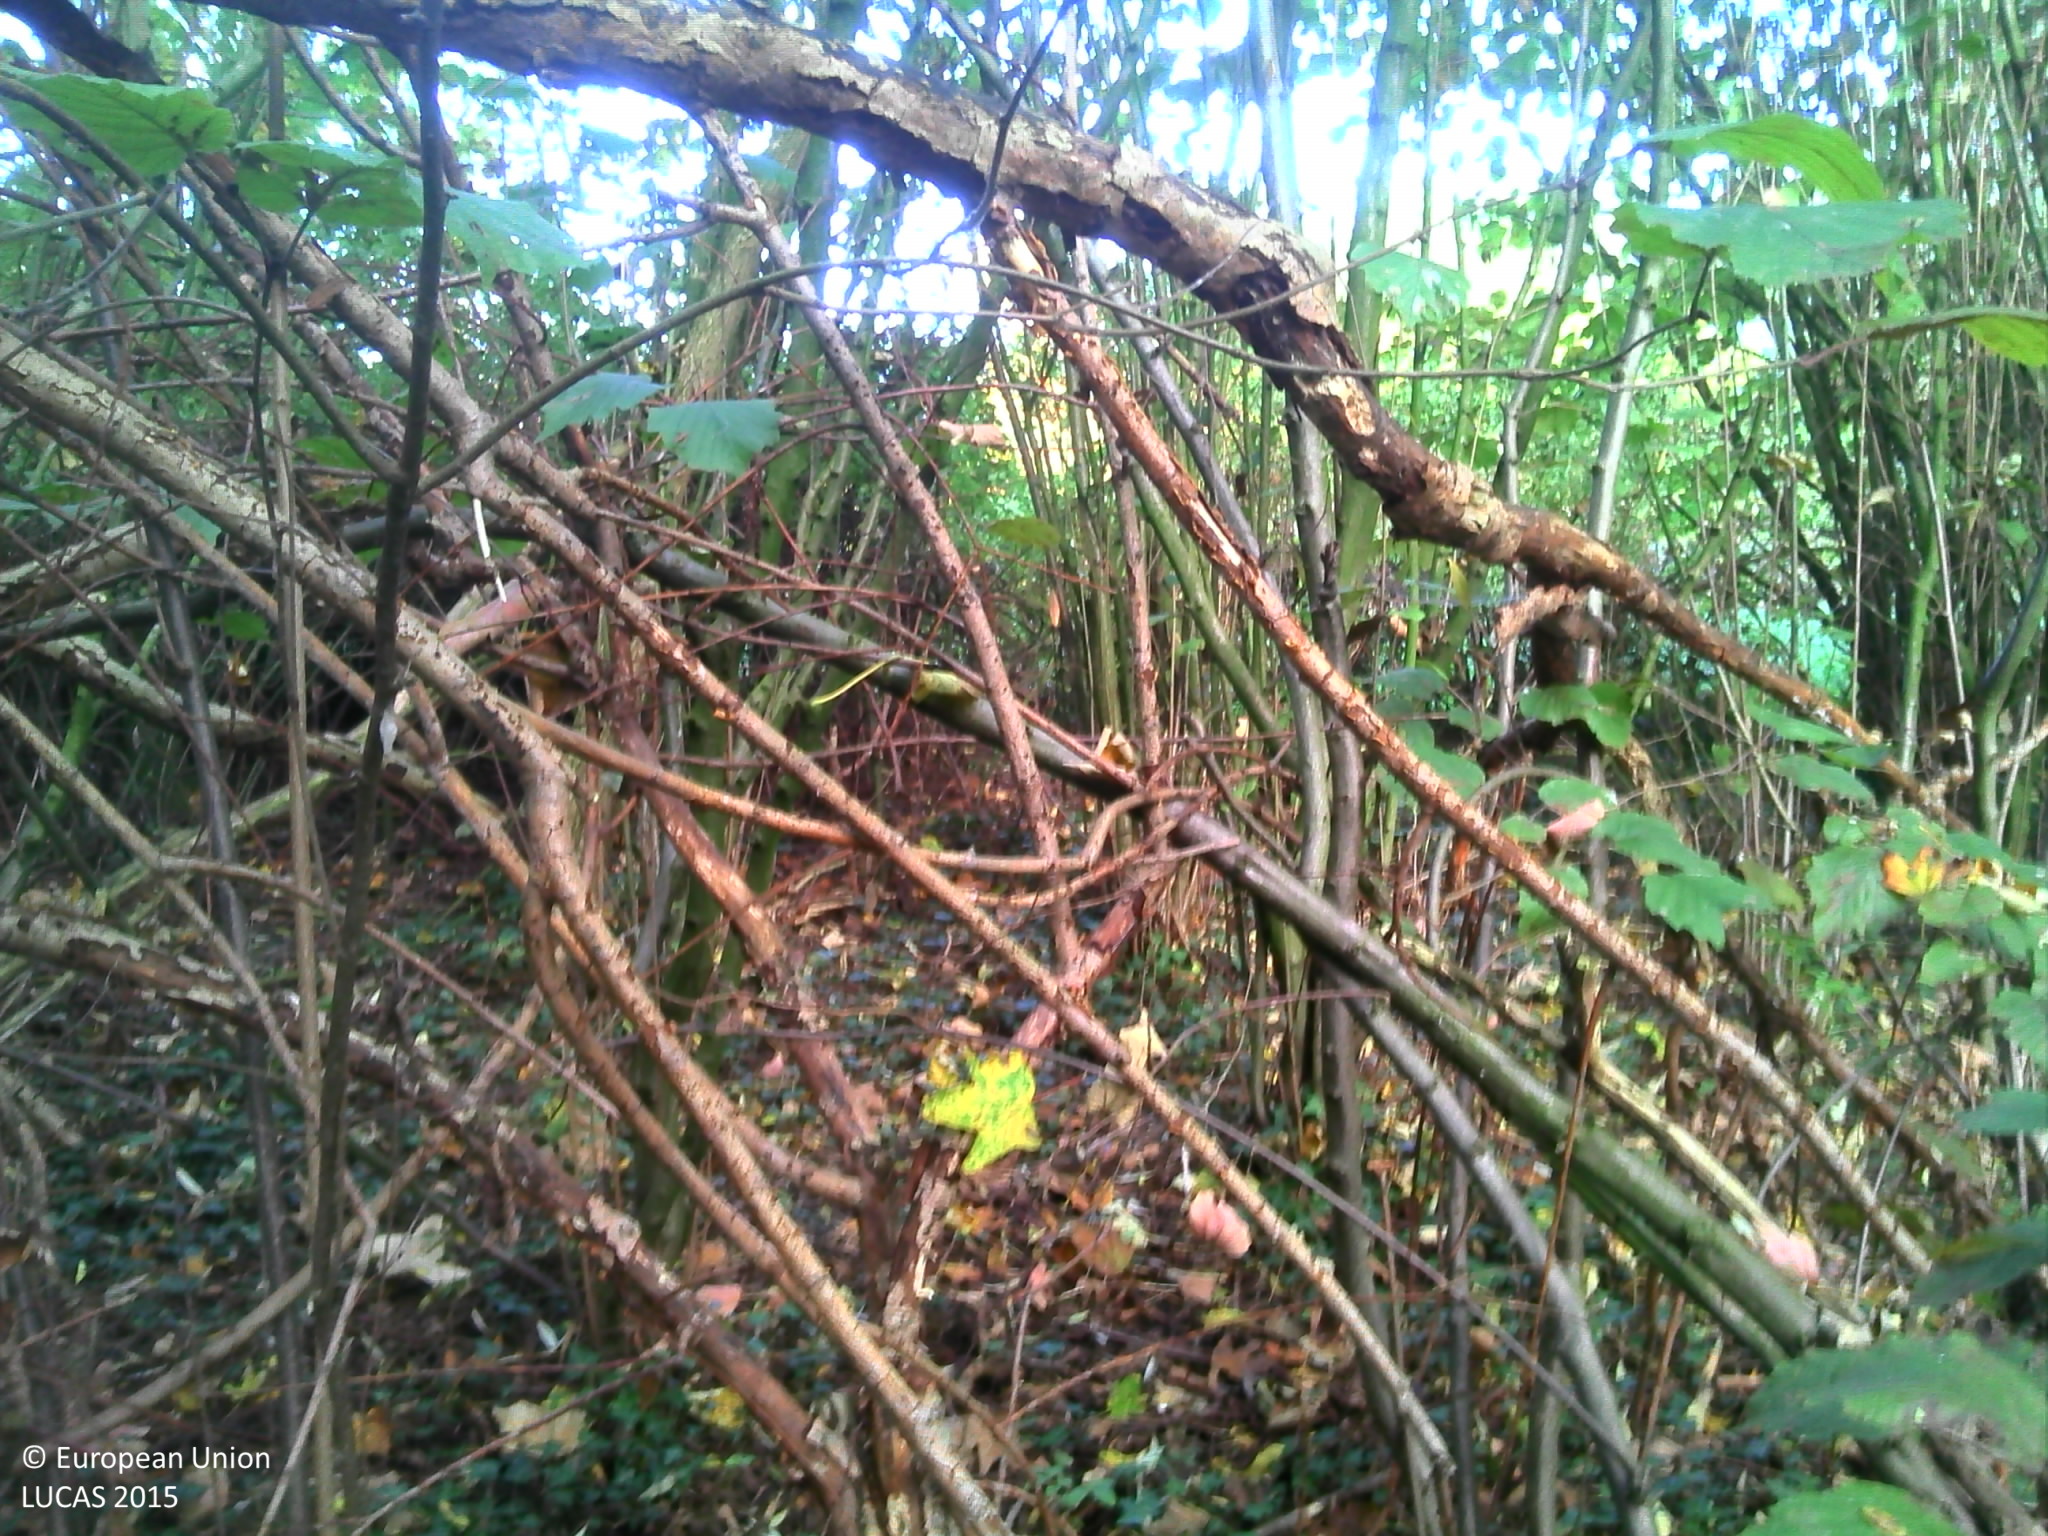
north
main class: Woodland
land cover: Broadleaved woodland
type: mesophytic deciduous forest
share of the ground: > 75 %
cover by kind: broadleaved forest trees 90 %, shrubs 5 %, herbaceous plants 5 %
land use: Amenities, museums, leisure
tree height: > 5 m
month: October
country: BE
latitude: 50.8790
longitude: 4.4669
